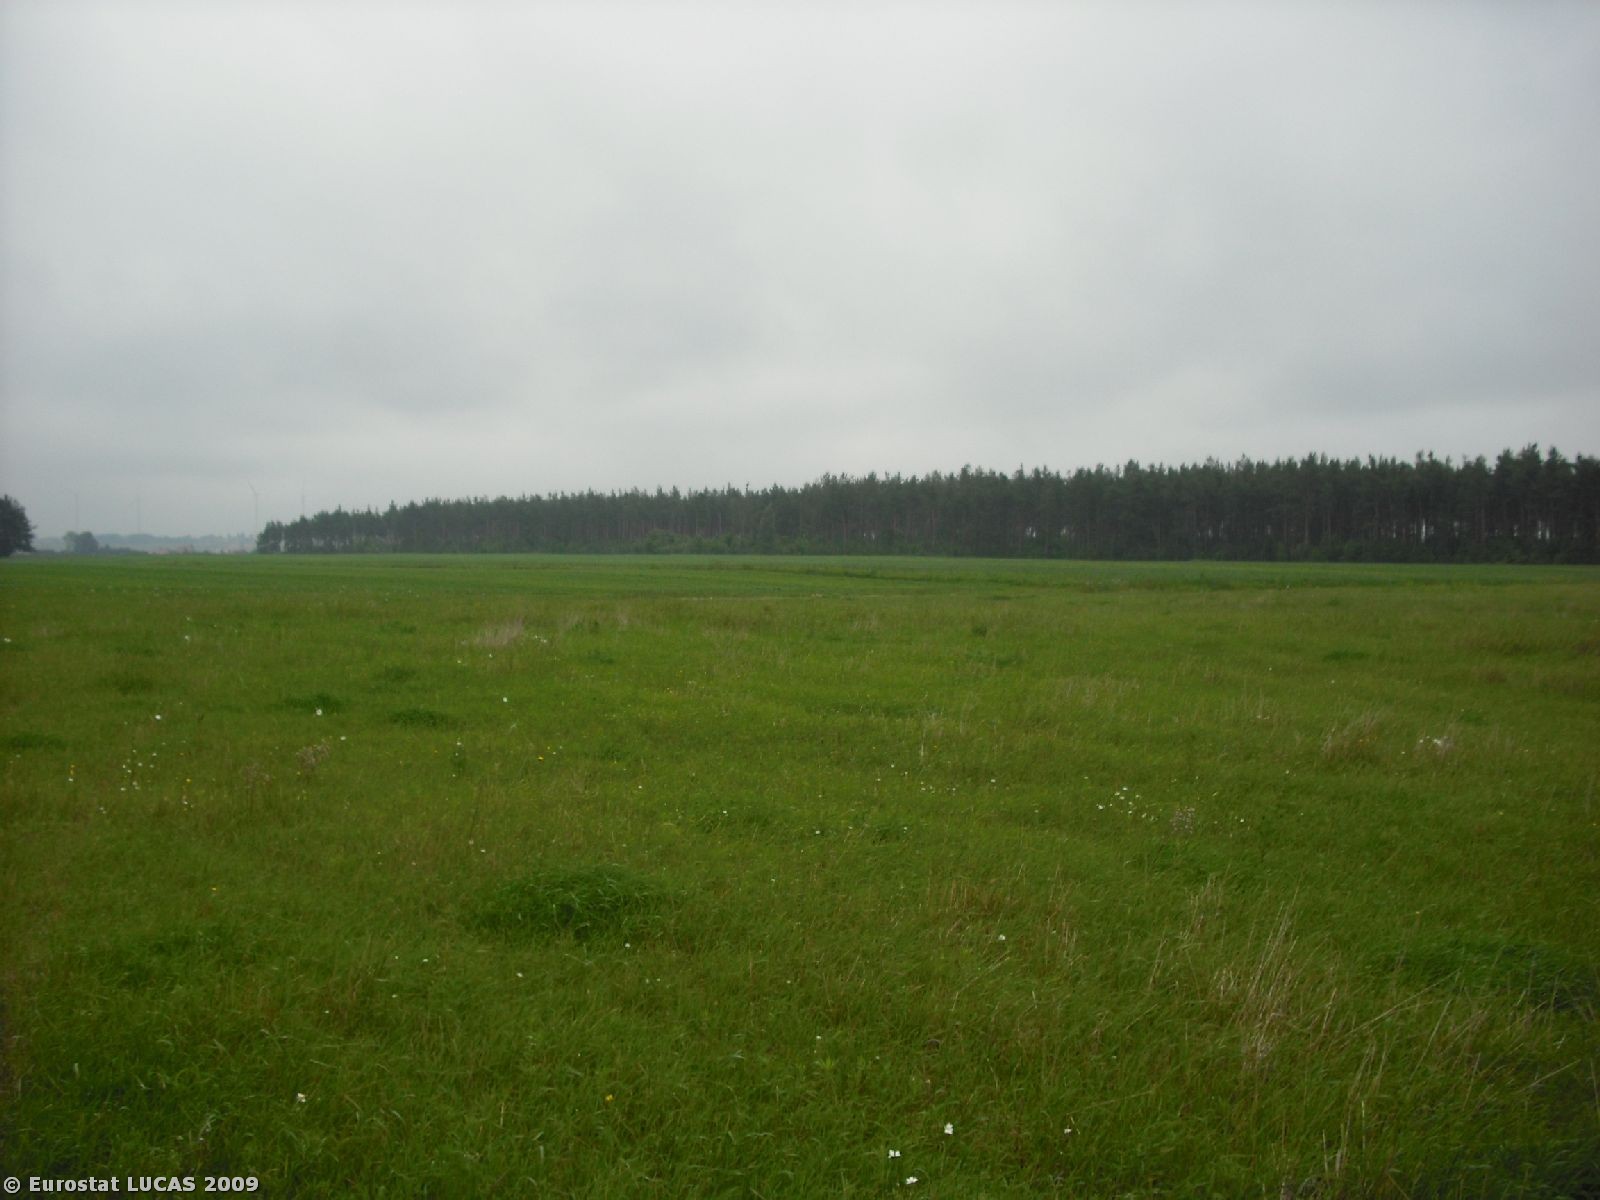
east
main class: Grassland
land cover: Grassland without tree/shrub cover
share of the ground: > 75 %
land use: Agriculture (excluding fallow land and kitchen gardens)
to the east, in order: Grassland without tree/shrub cover; Clovers; Grass margins; Oats
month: June
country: PL
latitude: 54.1379
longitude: 22.8201
